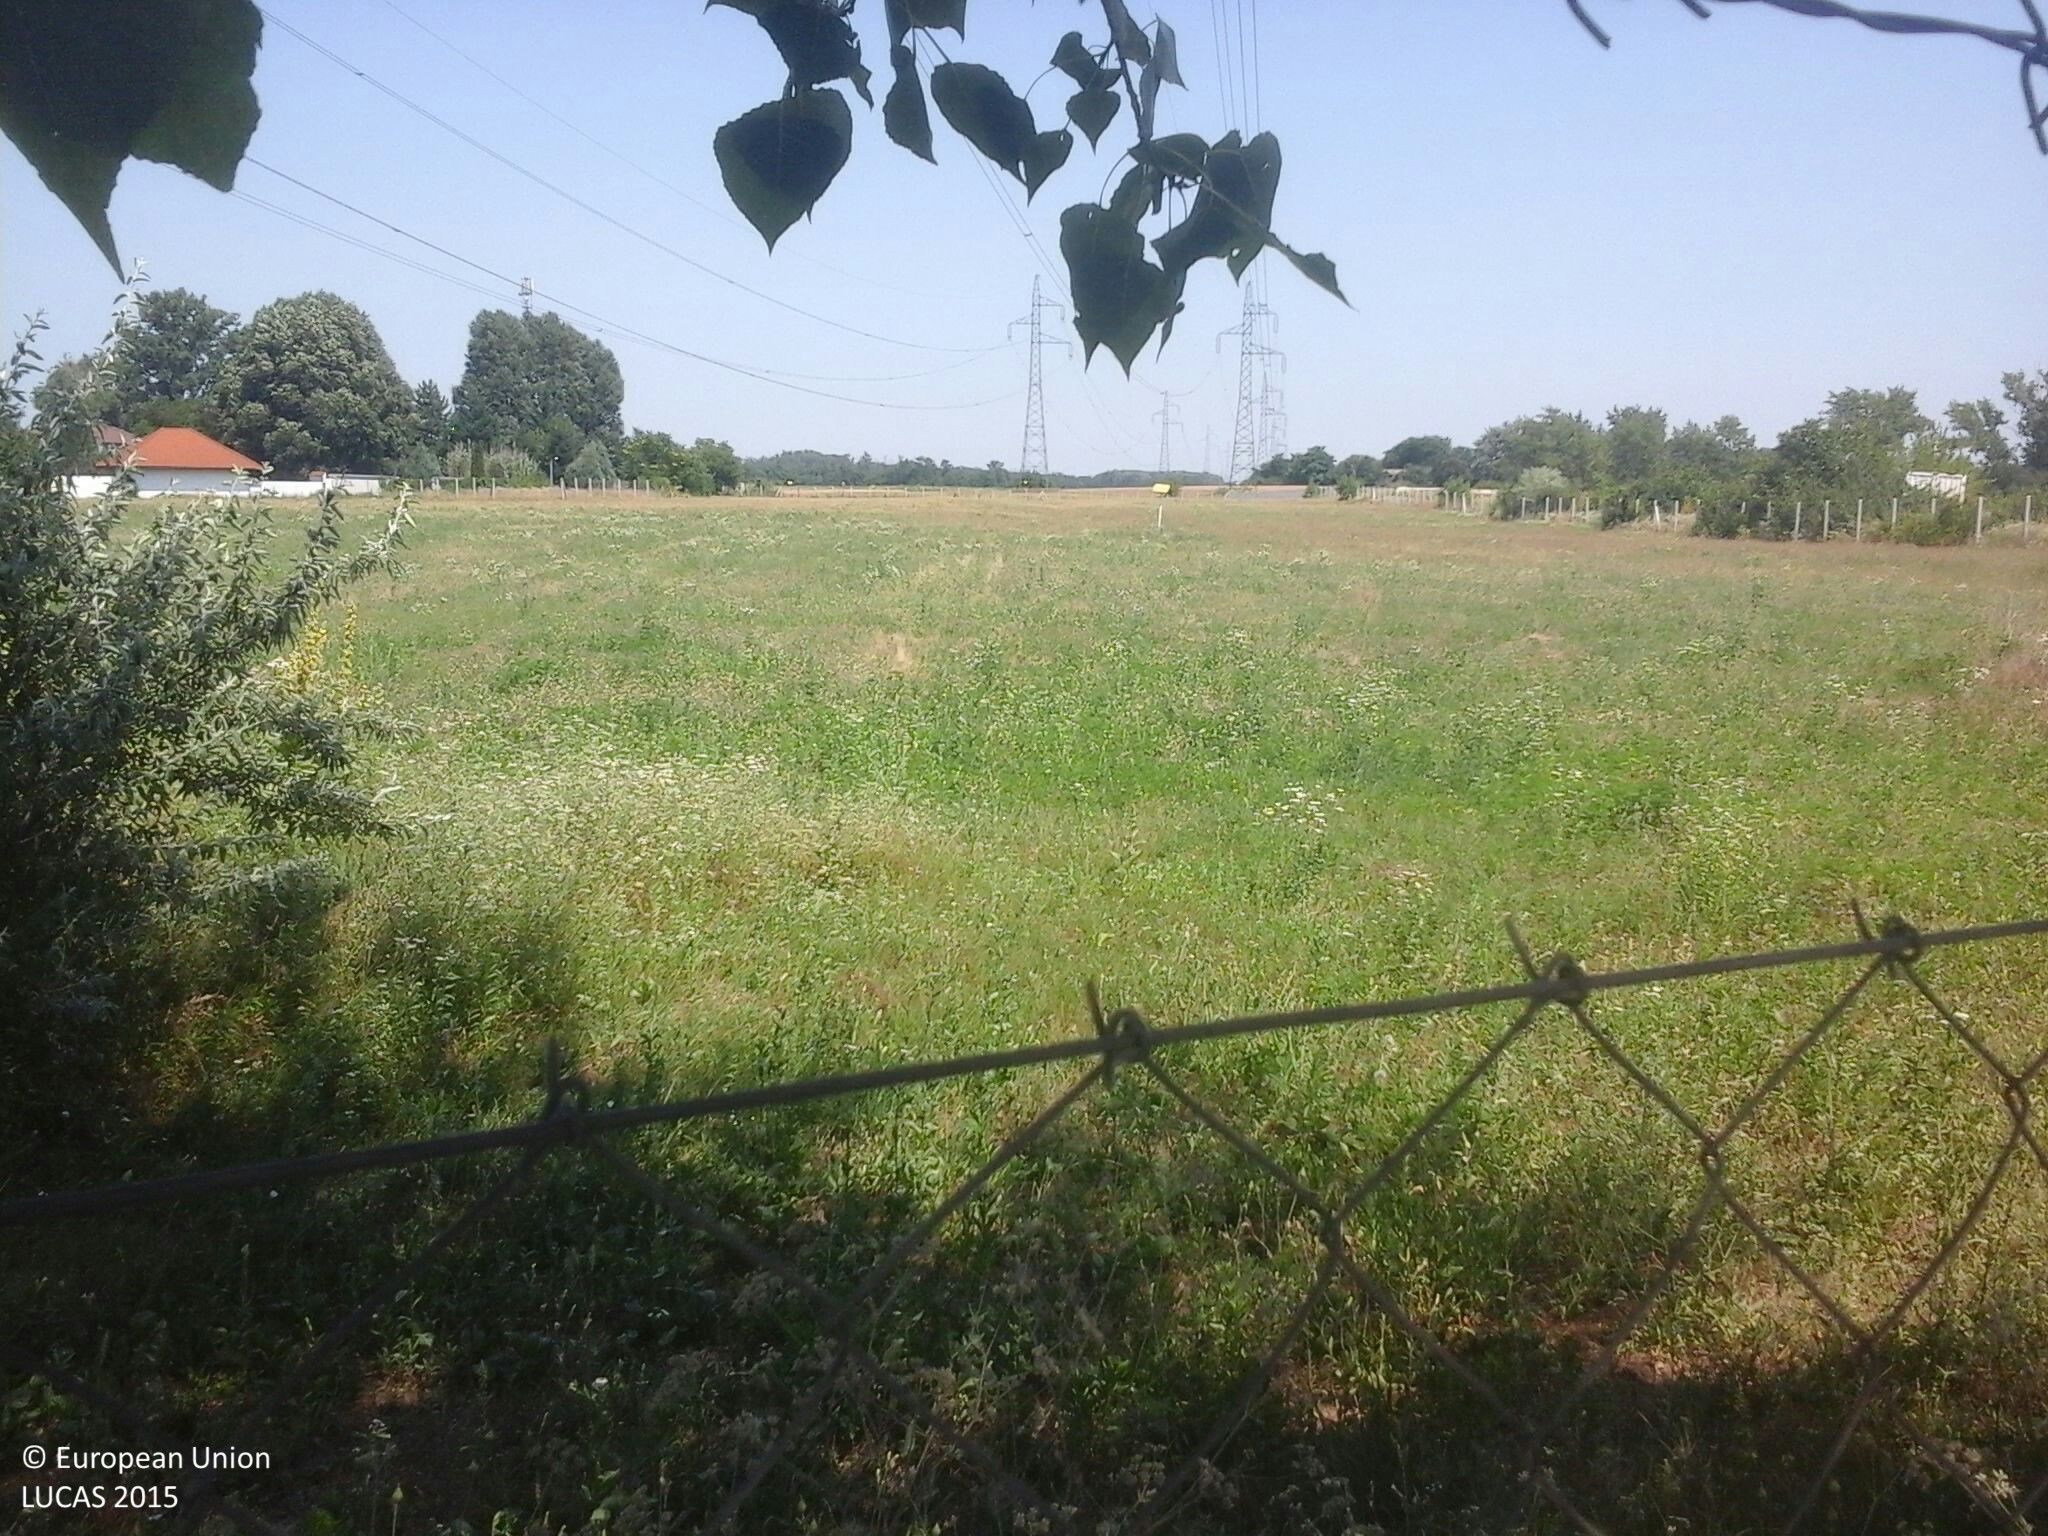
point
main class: Grassland
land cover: Spontaneously vegetated surfaces
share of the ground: > 75 %
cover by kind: herbaceous plants 100 %
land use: Semi-natural and natural areas not in use
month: July
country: HU
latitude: 47.2694
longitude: 19.0712
